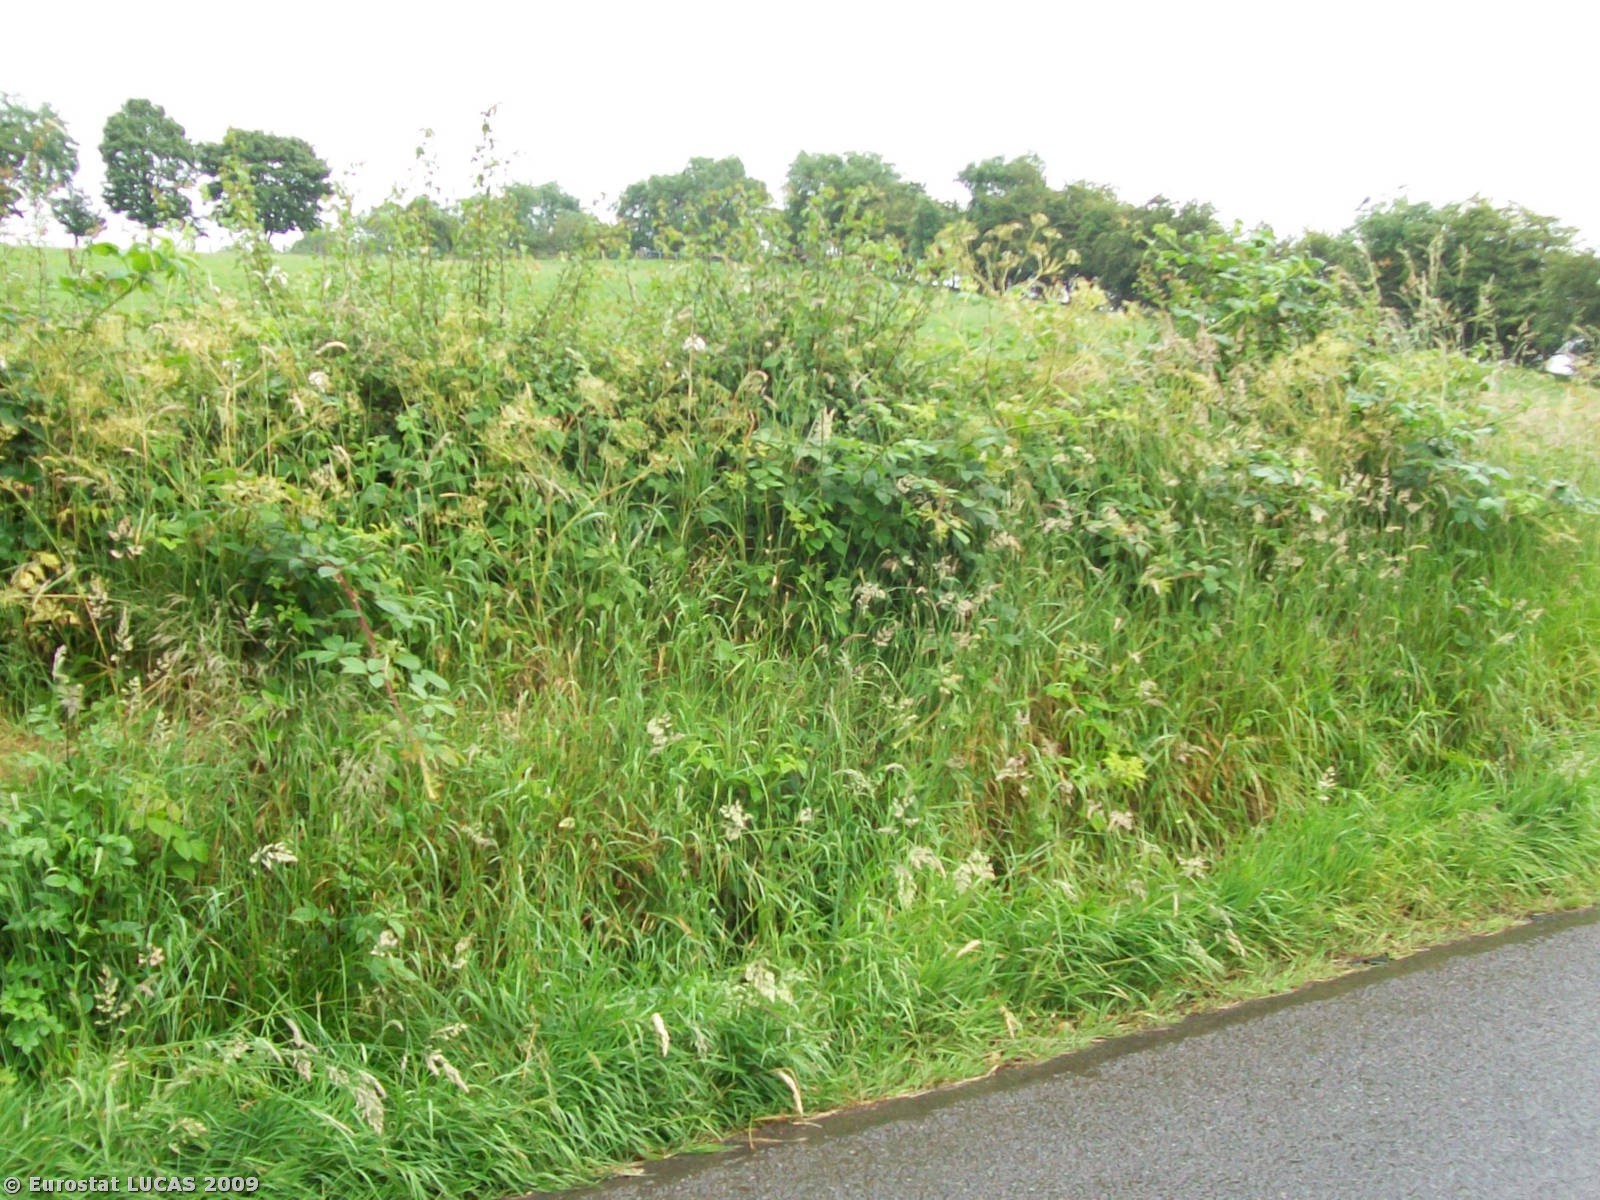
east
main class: Grassland
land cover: Grassland without tree/shrub cover
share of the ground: > 75 %
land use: Agriculture (excluding fallow land and kitchen gardens)
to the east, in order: Grassland without tree/shrub cover; Abandoned hedges; Grassland with sparse tree/shrub cover; Artificial constructions in urban areas; Broadleaved woodland; Managed hedges; Paved roads, cycling and walking lanes; Electric lines; Managed hedges; Grassland without tree/shrub cover; Managed hedges; Grassland without tree/shrub cover
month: June
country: GB
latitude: 54.4830
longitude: -7.4251
